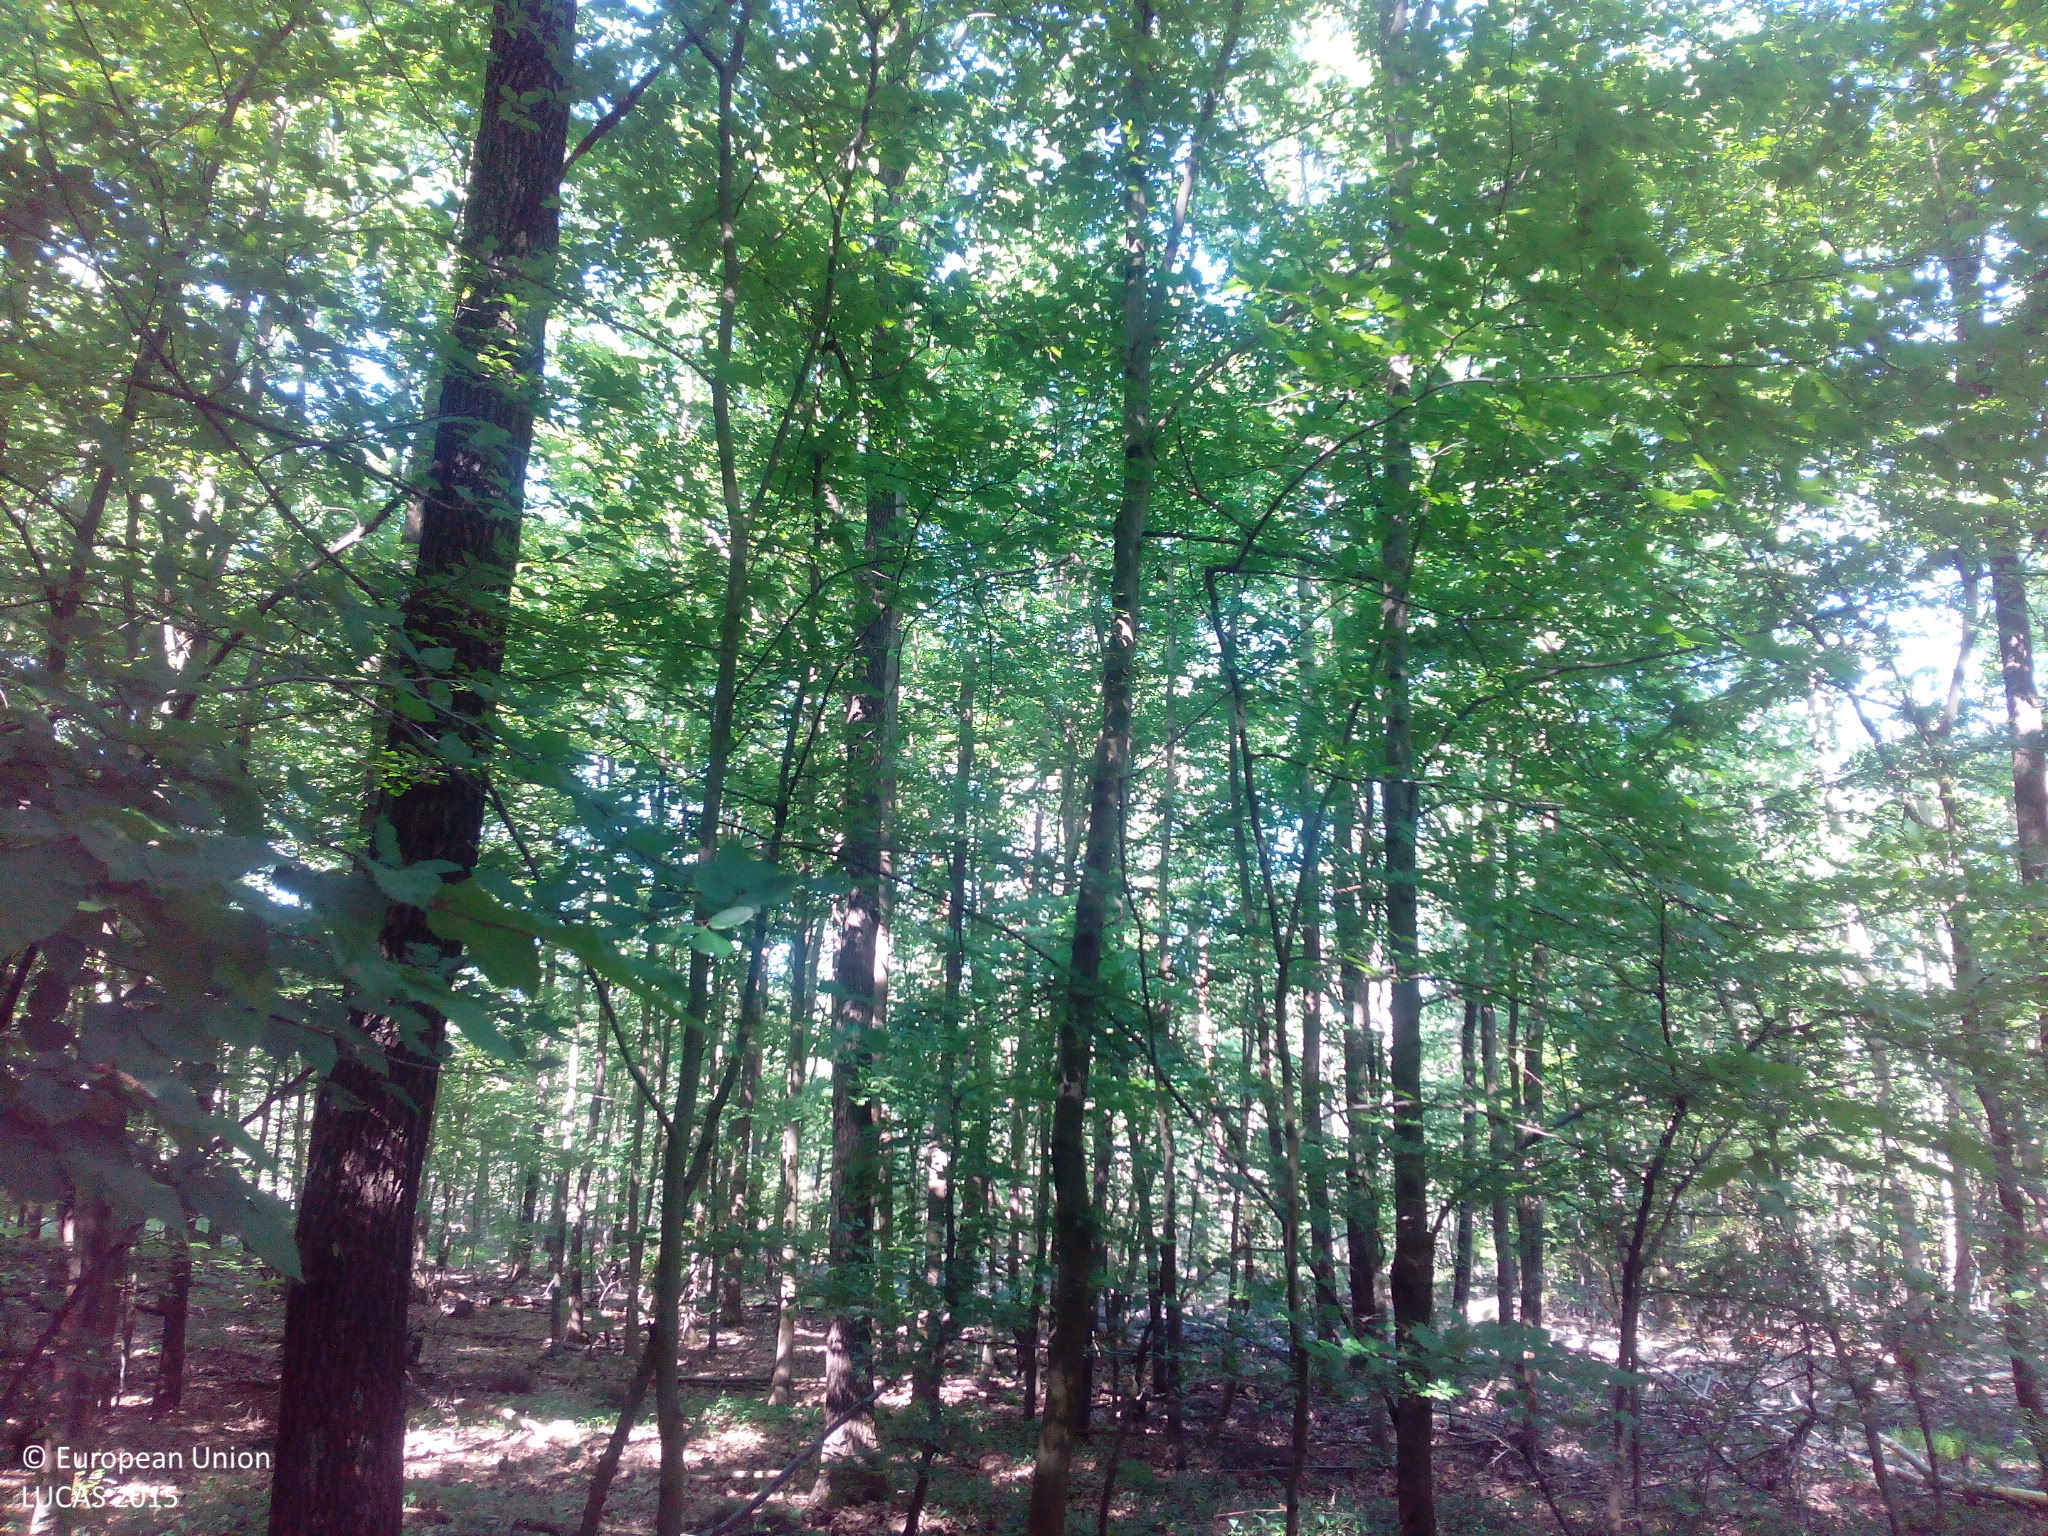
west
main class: Woodland
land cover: Broadleaved woodland
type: mesophytic deciduous forest
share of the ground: > 75 %
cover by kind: broadleaved forest trees 95 %, herbaceous plants 5 %
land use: Forestry
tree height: > 5 m
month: June
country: DE
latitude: 51.0773
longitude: 12.3549
